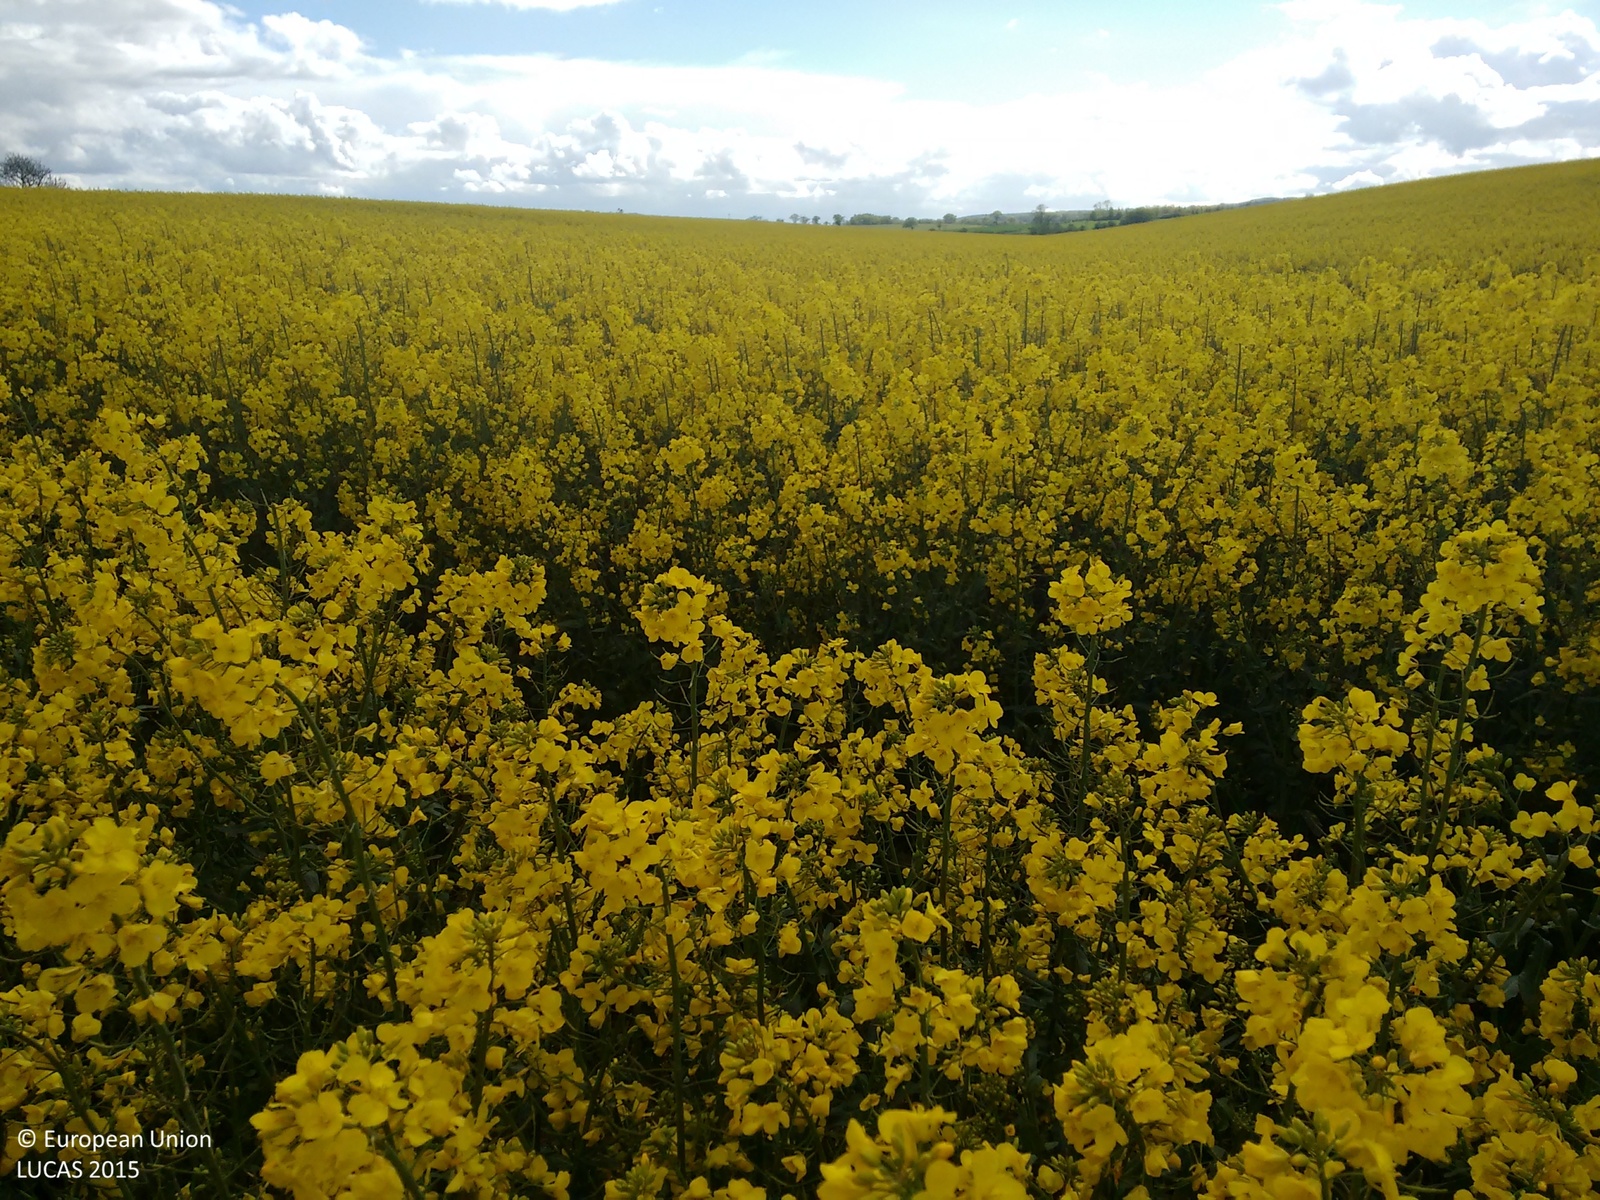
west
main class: Cropland
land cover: Rape and turnip rape
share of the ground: > 75 %
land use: Agriculture (excluding fallow land and kitchen gardens)
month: May
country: GB
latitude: 55.7530
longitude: -2.3420
